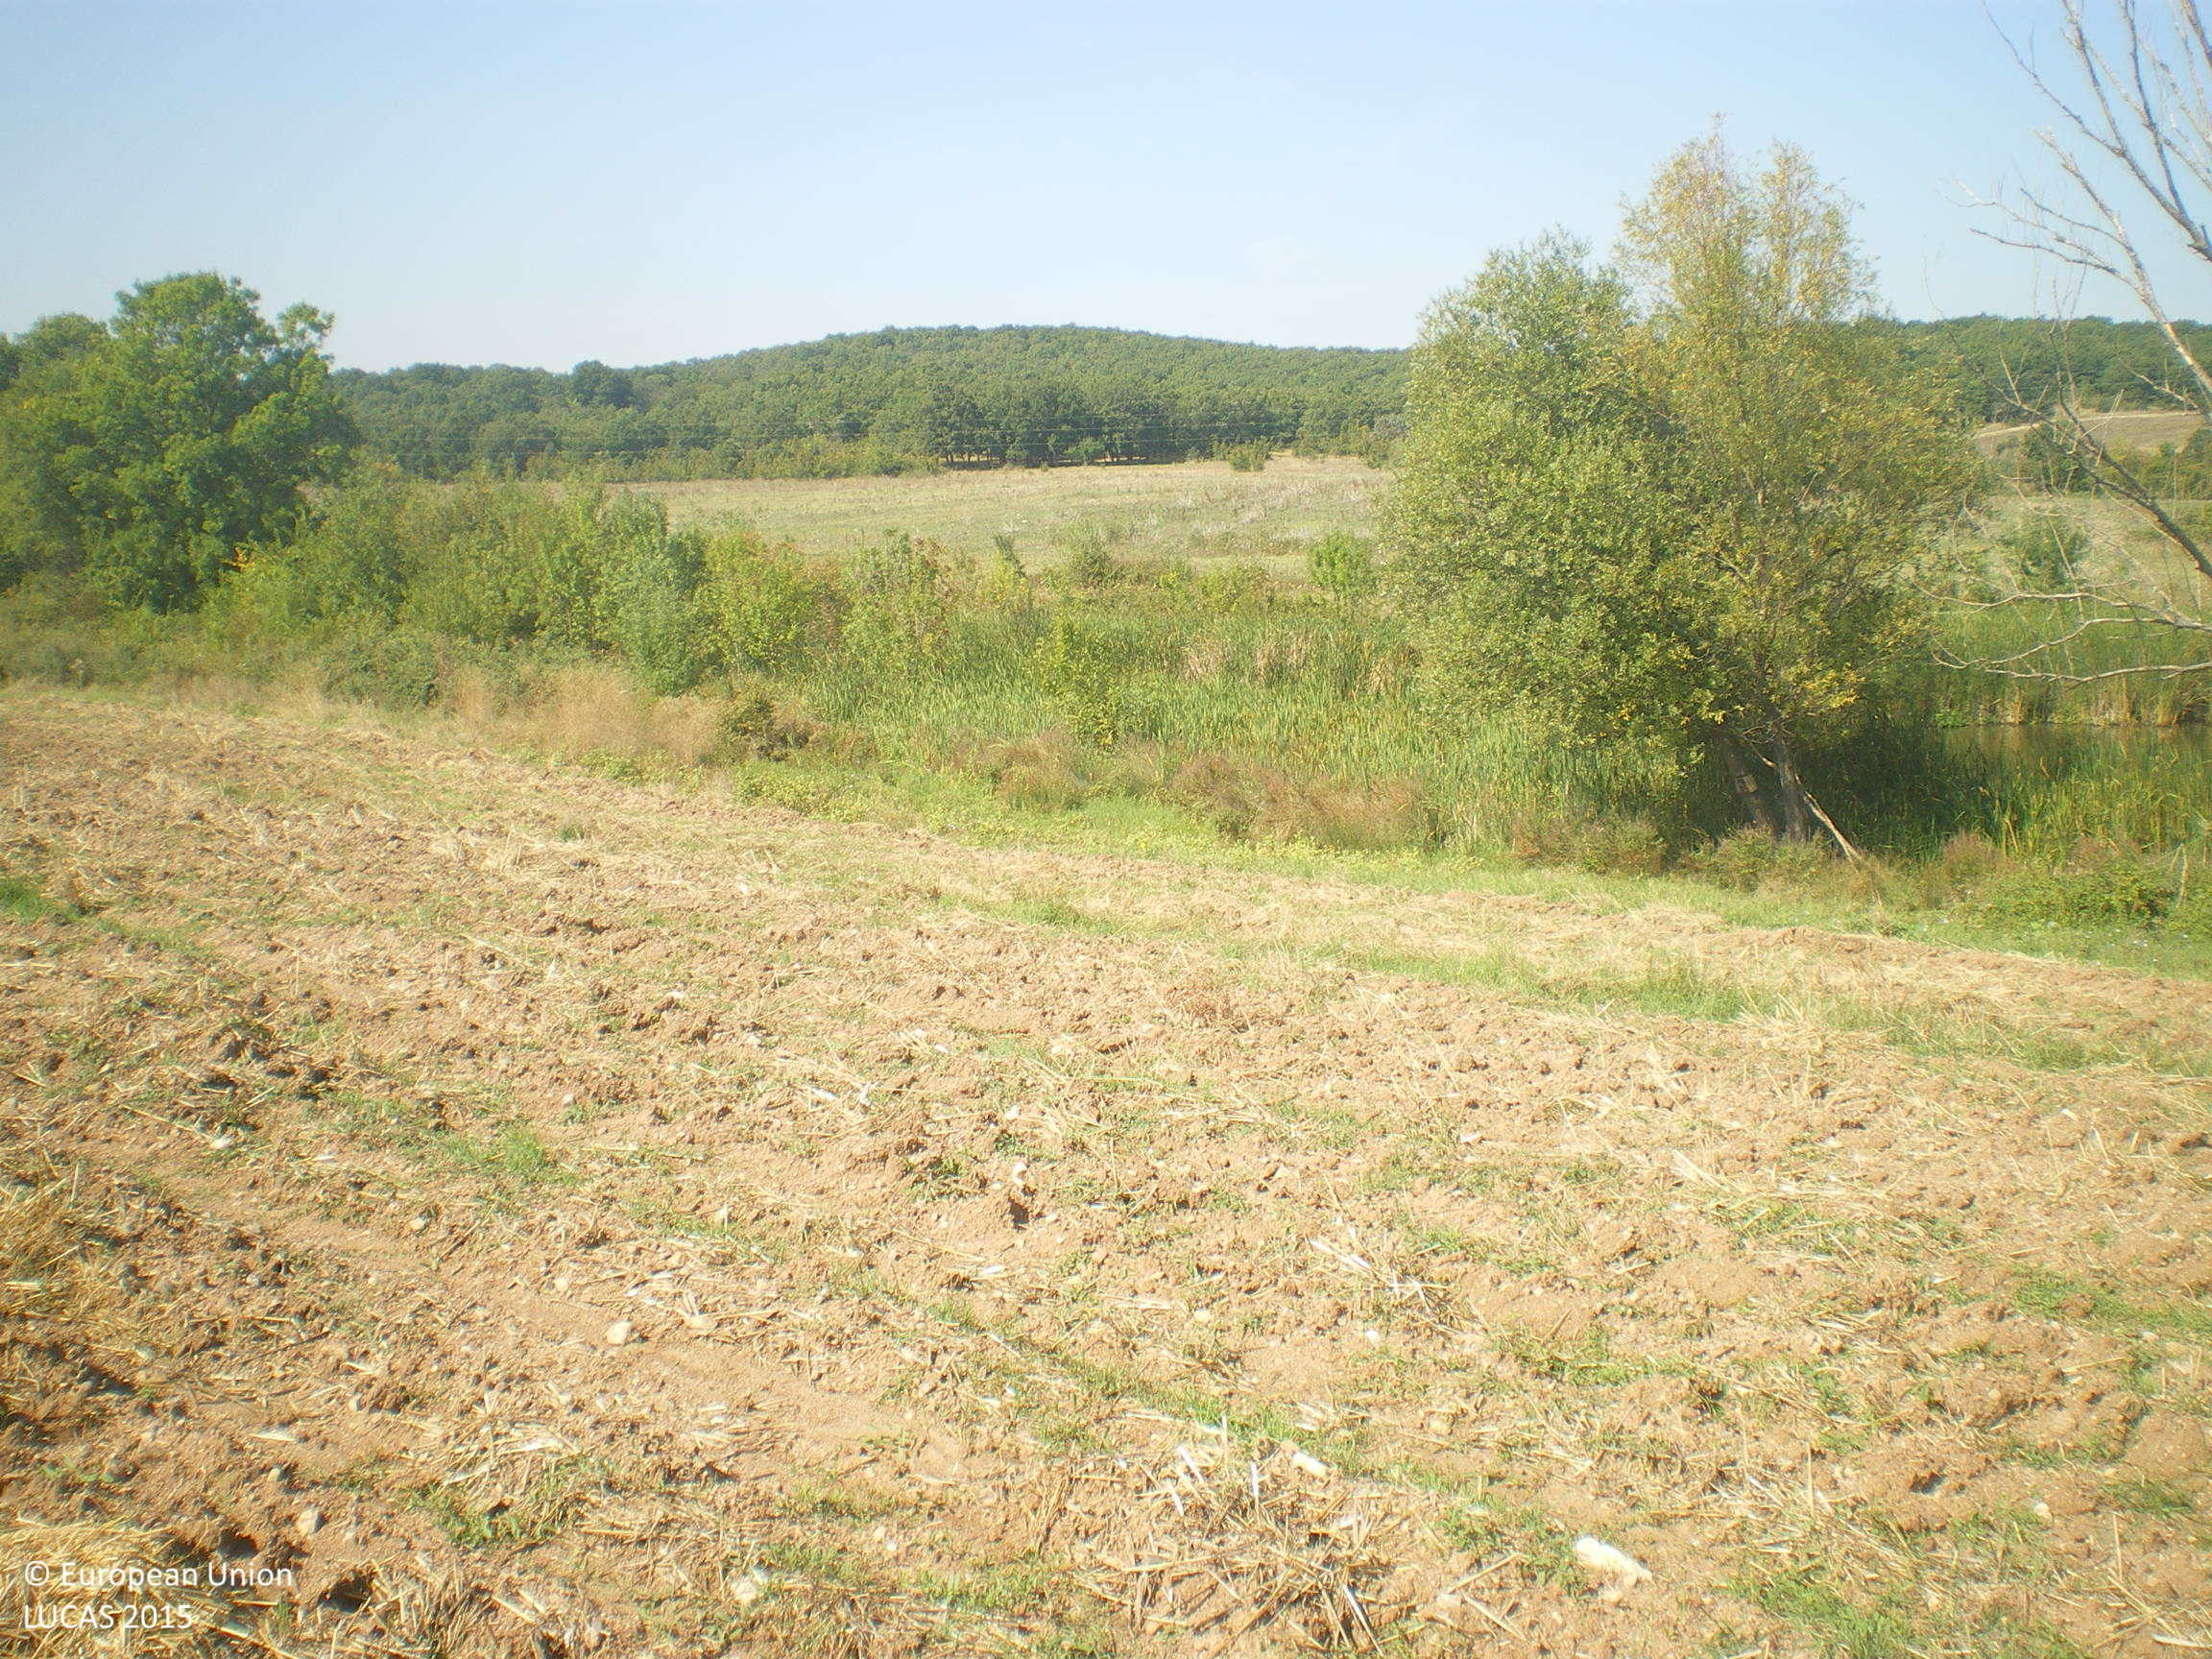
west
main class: Cropland
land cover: Common wheat
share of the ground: < 10 %
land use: Agriculture (excluding fallow land and kitchen gardens)
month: September
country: BG
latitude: 41.7924
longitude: 26.0168
